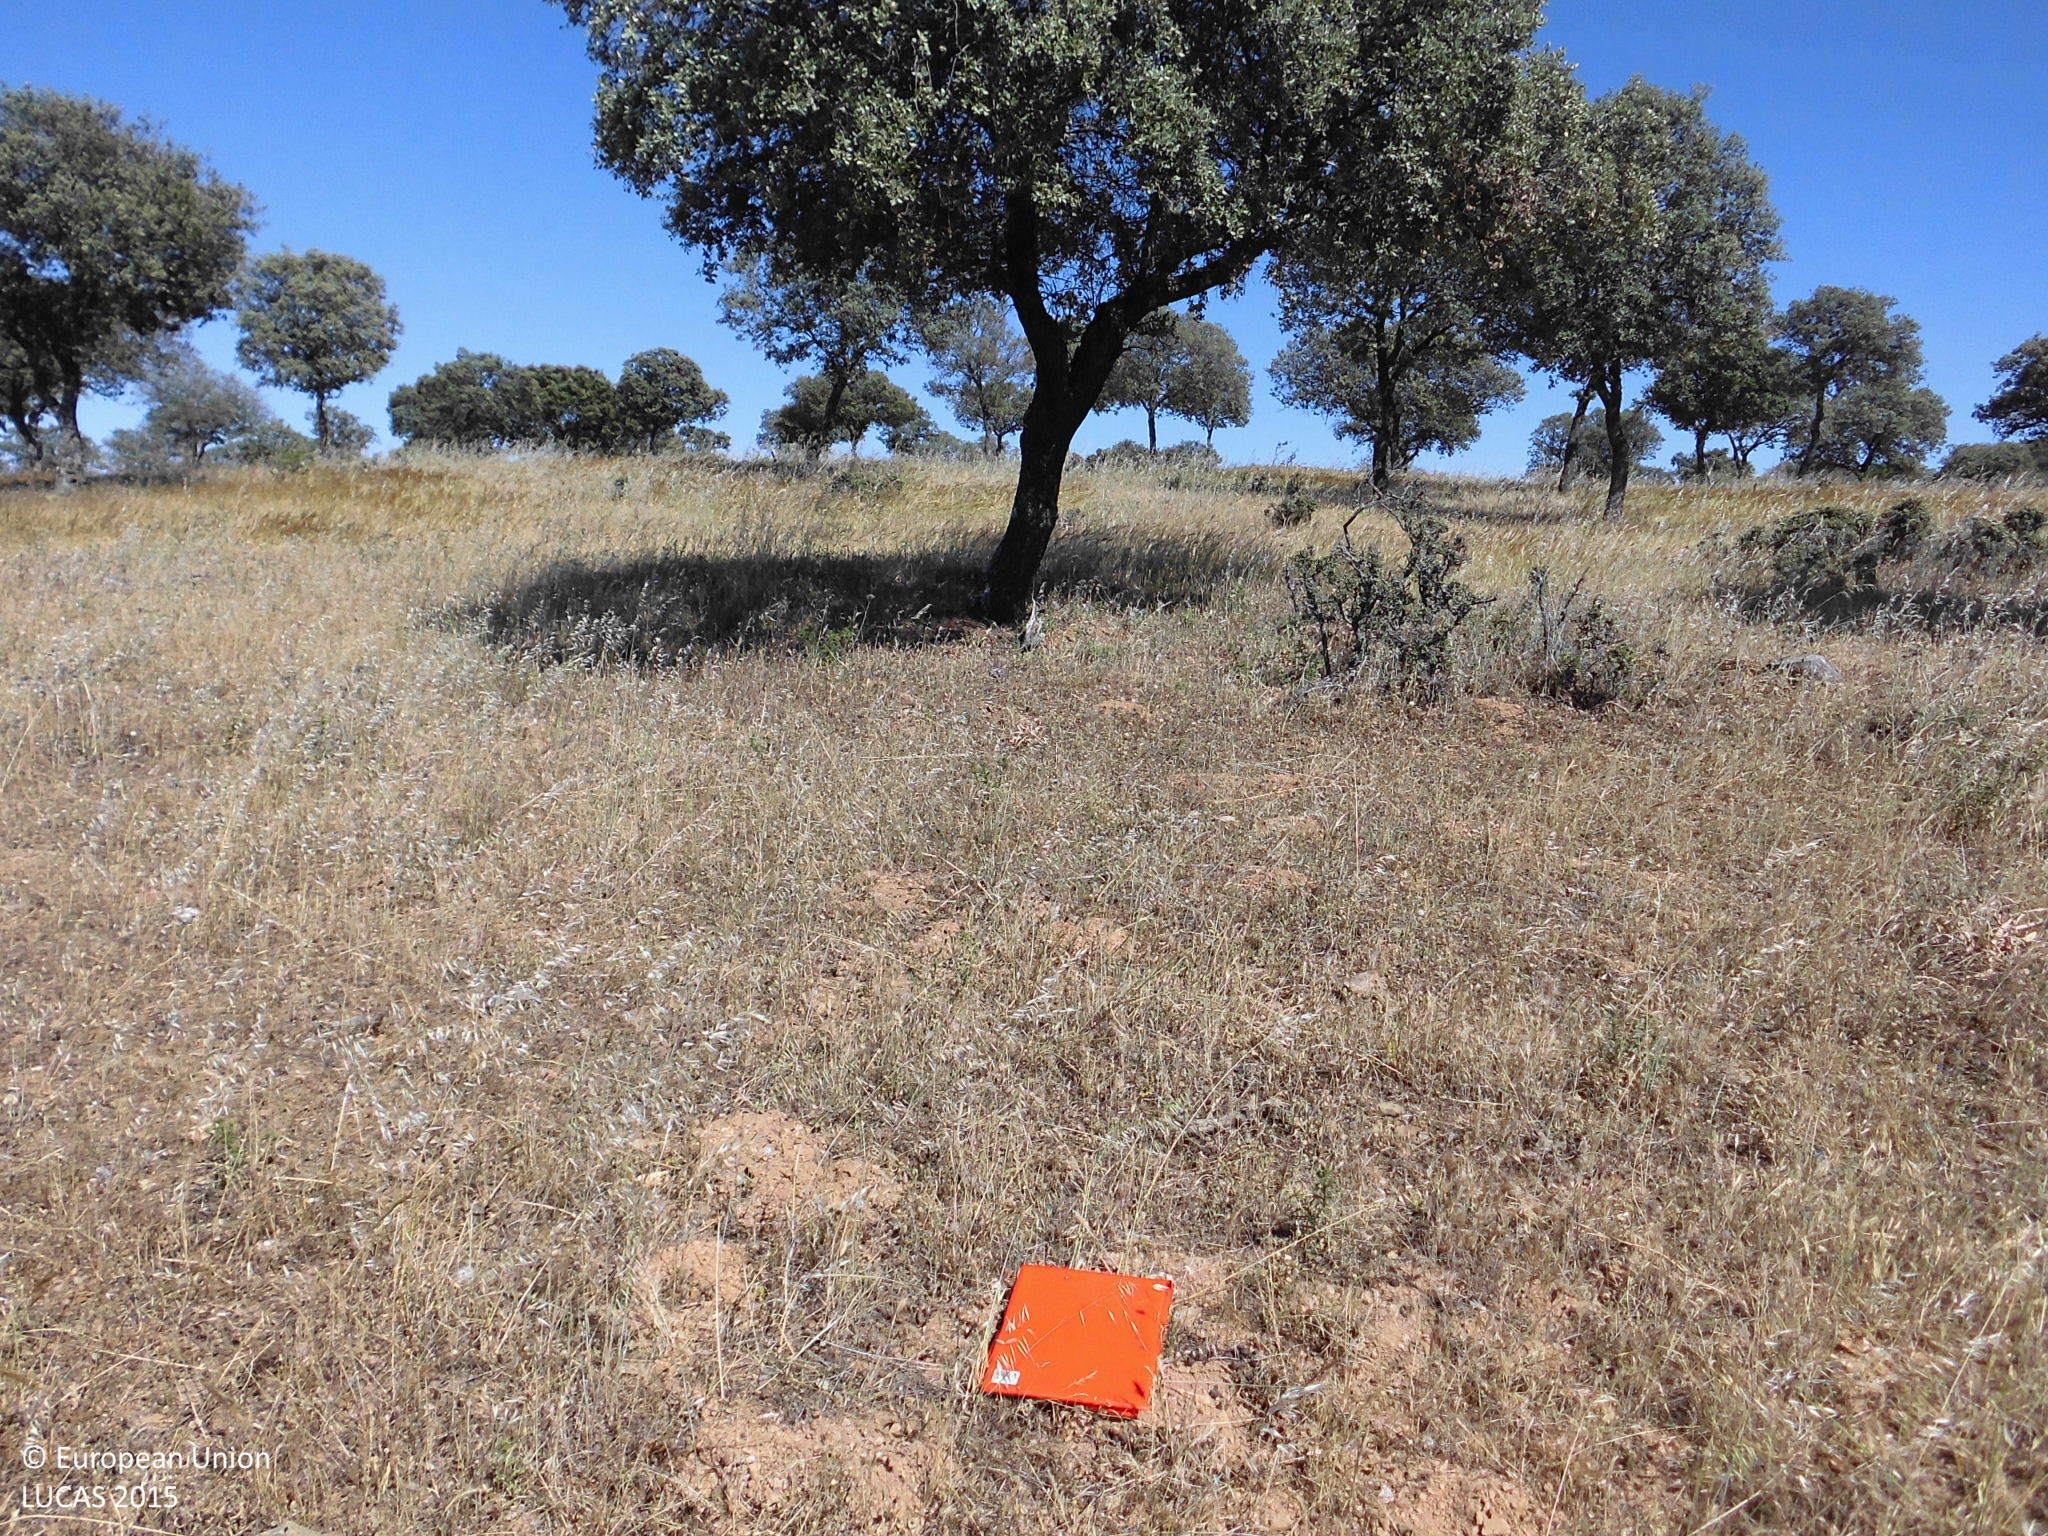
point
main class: Woodland
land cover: Broadleaved woodland
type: broadleaved evergreen forest
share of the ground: 10 - 25 %
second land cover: Grassland without tree/shrub cover
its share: > 75 %
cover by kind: herbaceous plants 85 %, broadleaved forest trees 15 %
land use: Forestry
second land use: Agriculture (excluding fallow land and kitchen gardens)
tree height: > 5 m
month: May
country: ES
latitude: 39.4443
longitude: -6.8445
